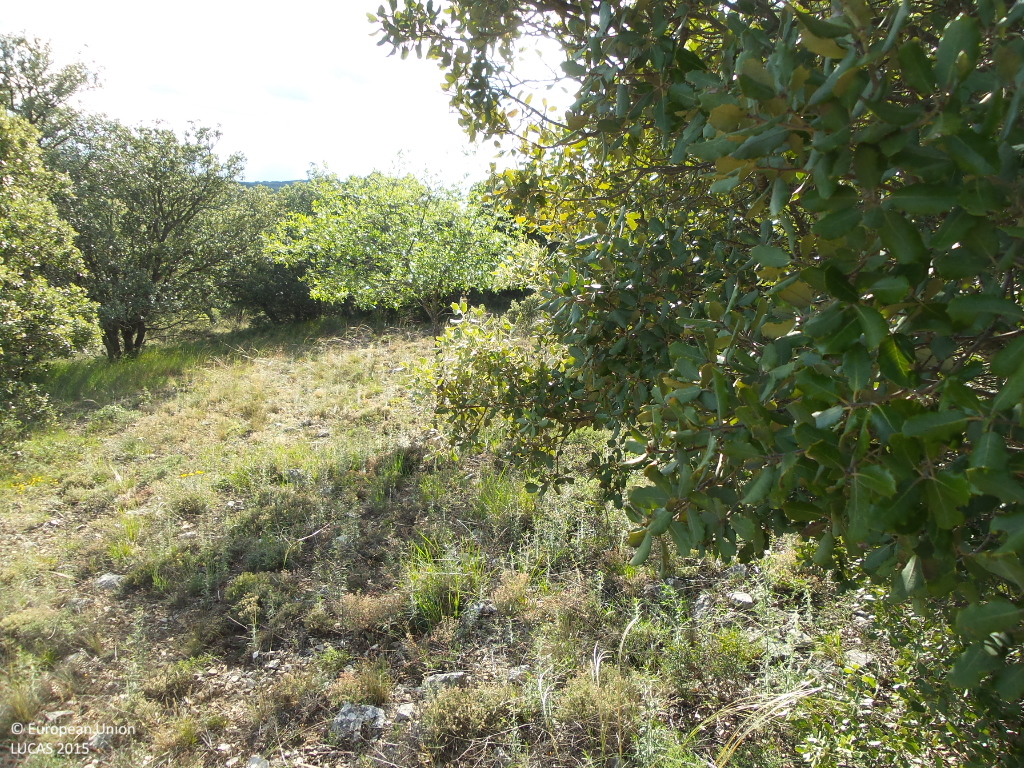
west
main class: Woodland
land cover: Broadleaved woodland
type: broadleaved evergreen forest
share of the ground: 50 - 75 %
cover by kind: broadleaved forest trees 50 %, shrubs 30 %, herbaceous plants 10 %, unconsolidated bare surface 10 %
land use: Semi-natural and natural areas not in use
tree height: < 5 m
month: June
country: ES
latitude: 41.3783
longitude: -2.9653
